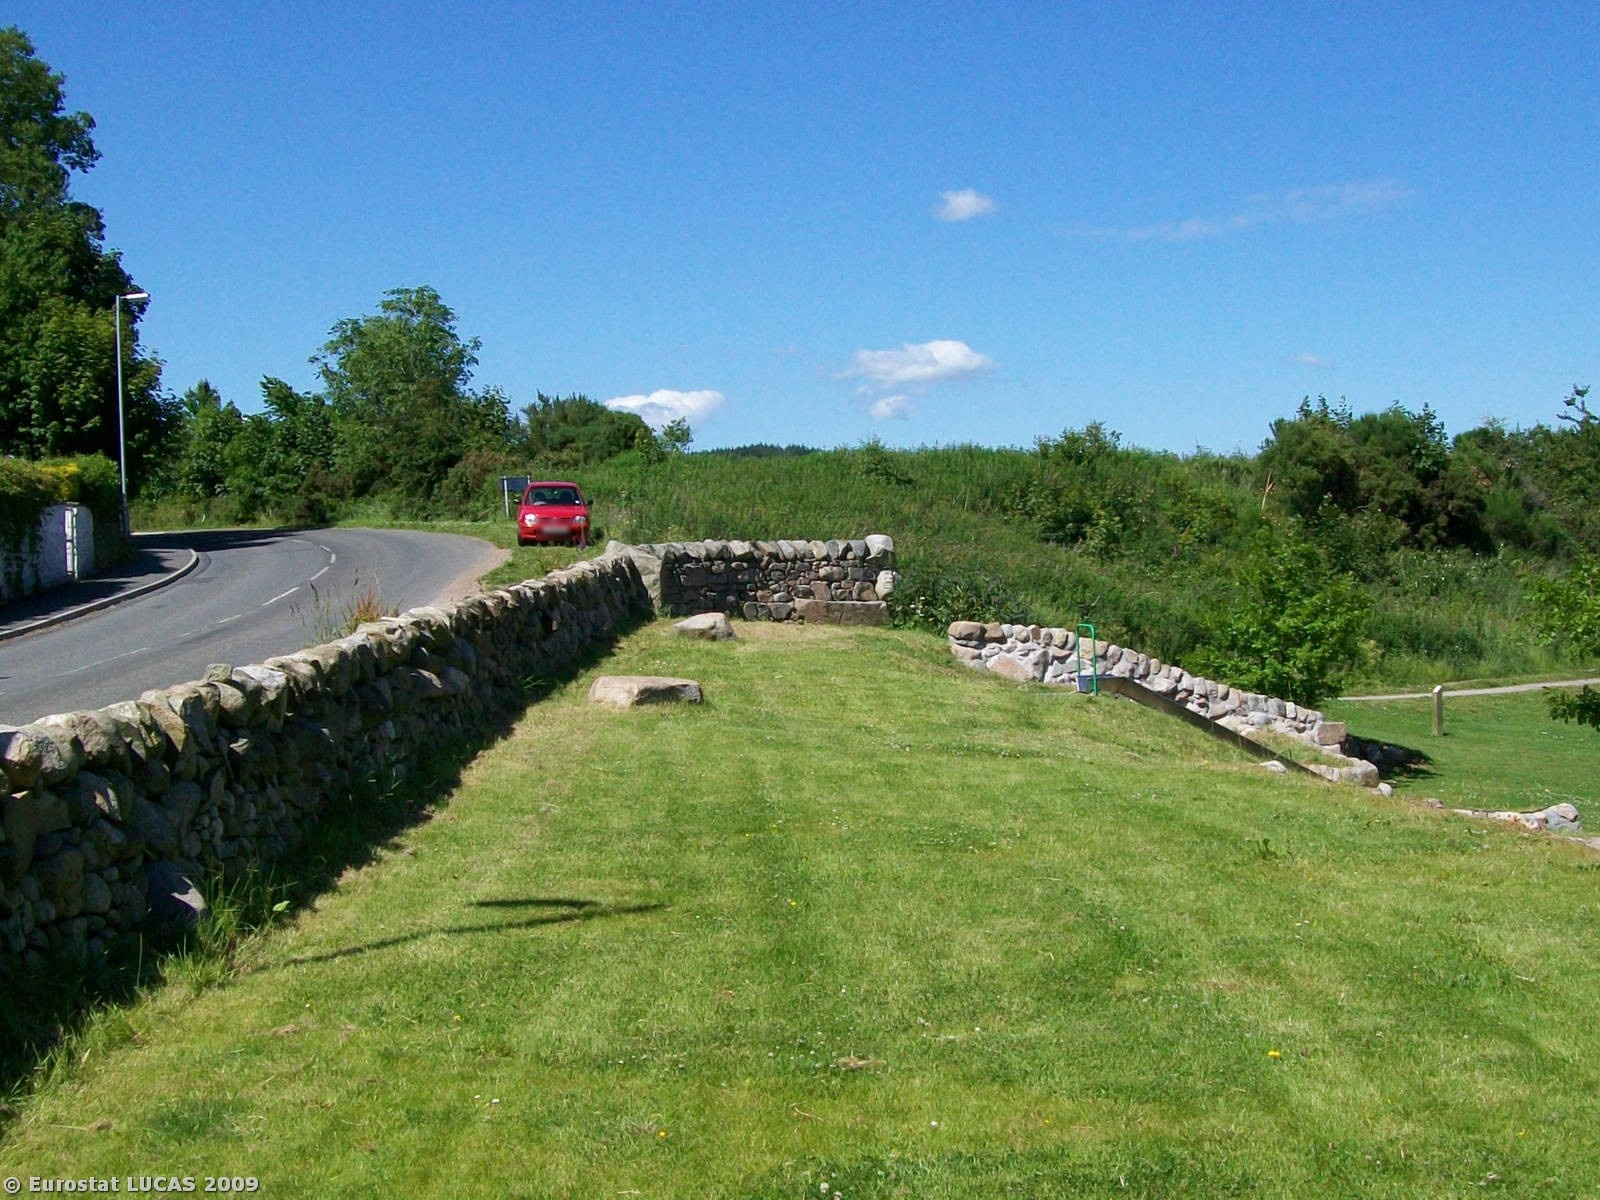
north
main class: Grassland
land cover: Grassland with sparse tree/shrub cover
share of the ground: > 75 %
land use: Amenities, museums, leisure
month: June
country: GB
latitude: 54.8447
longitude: -3.8705
